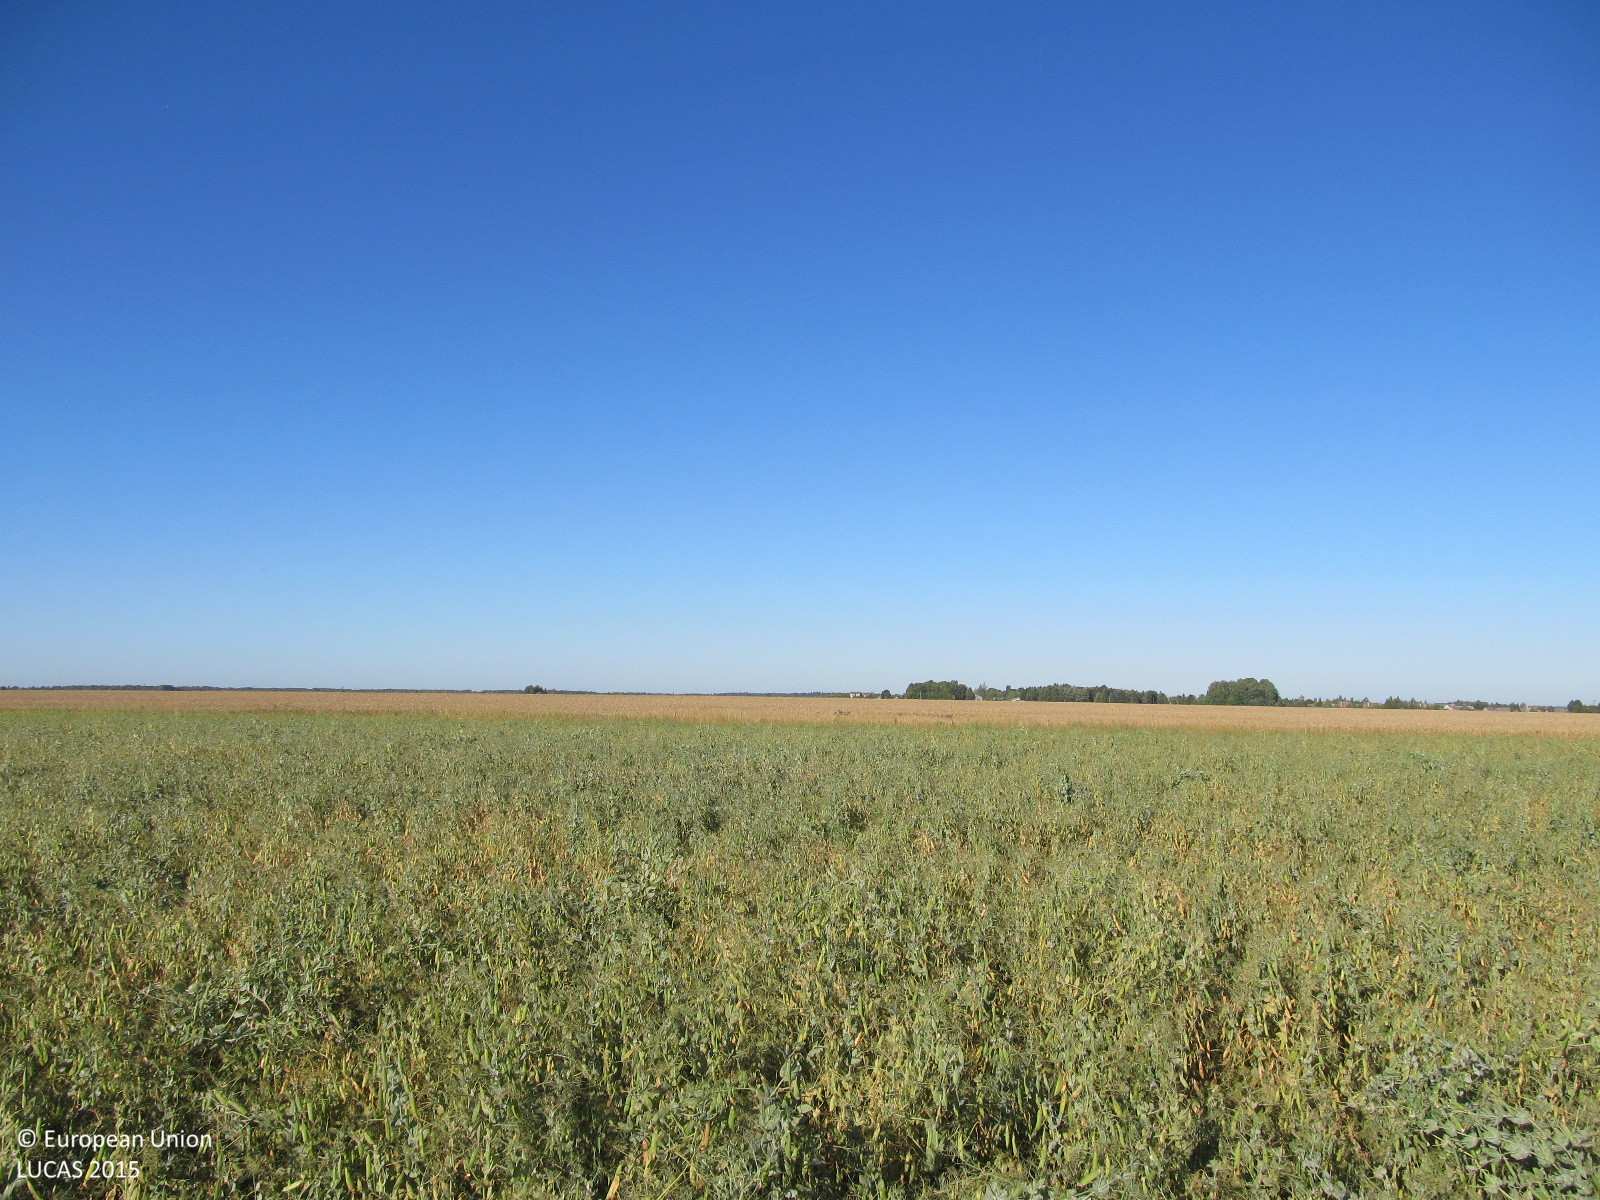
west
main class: Cropland
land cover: Dry pulses
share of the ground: > 75 %
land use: Agriculture (excluding fallow land and kitchen gardens)
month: August
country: LT
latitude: 56.3346
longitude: 22.7267
